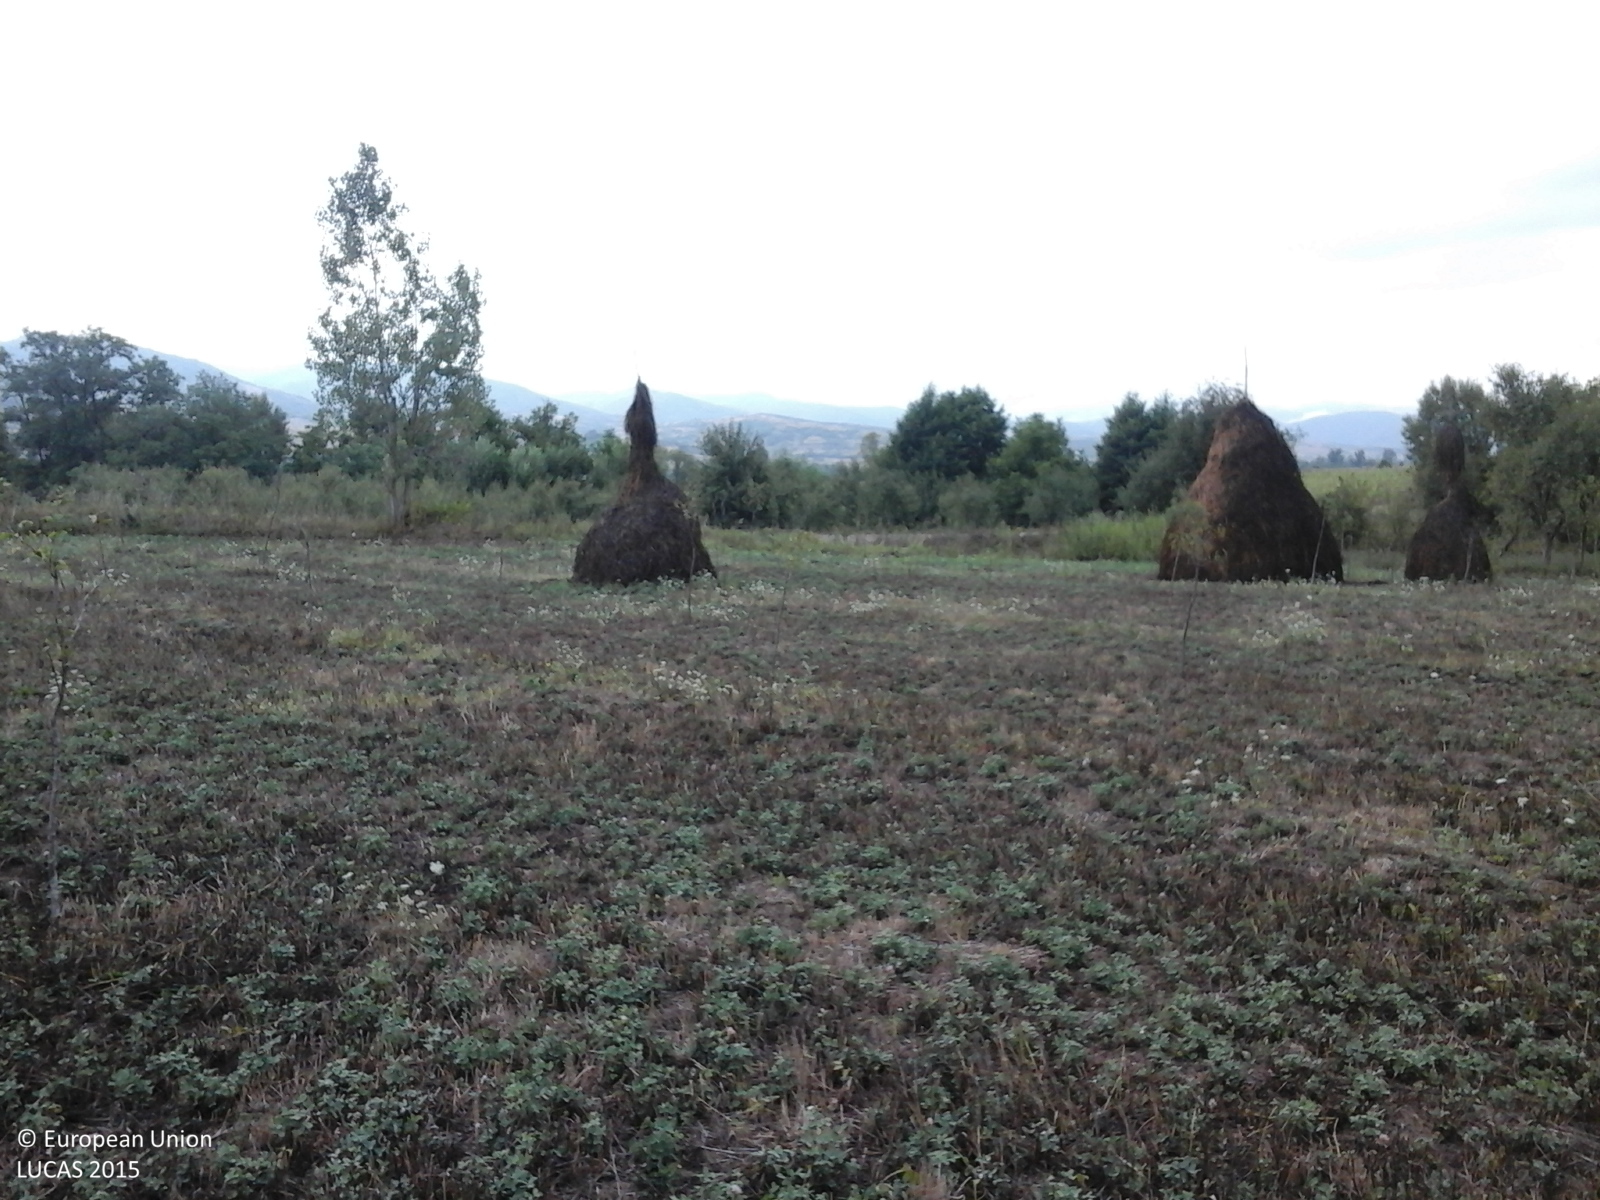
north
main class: Cropland
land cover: Apple fruit
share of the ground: > 75 %
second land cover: Lucerne
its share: > 75 %
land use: Agriculture (excluding fallow land and kitchen gardens)
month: August
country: RO
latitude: 44.8603
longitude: 21.9421
